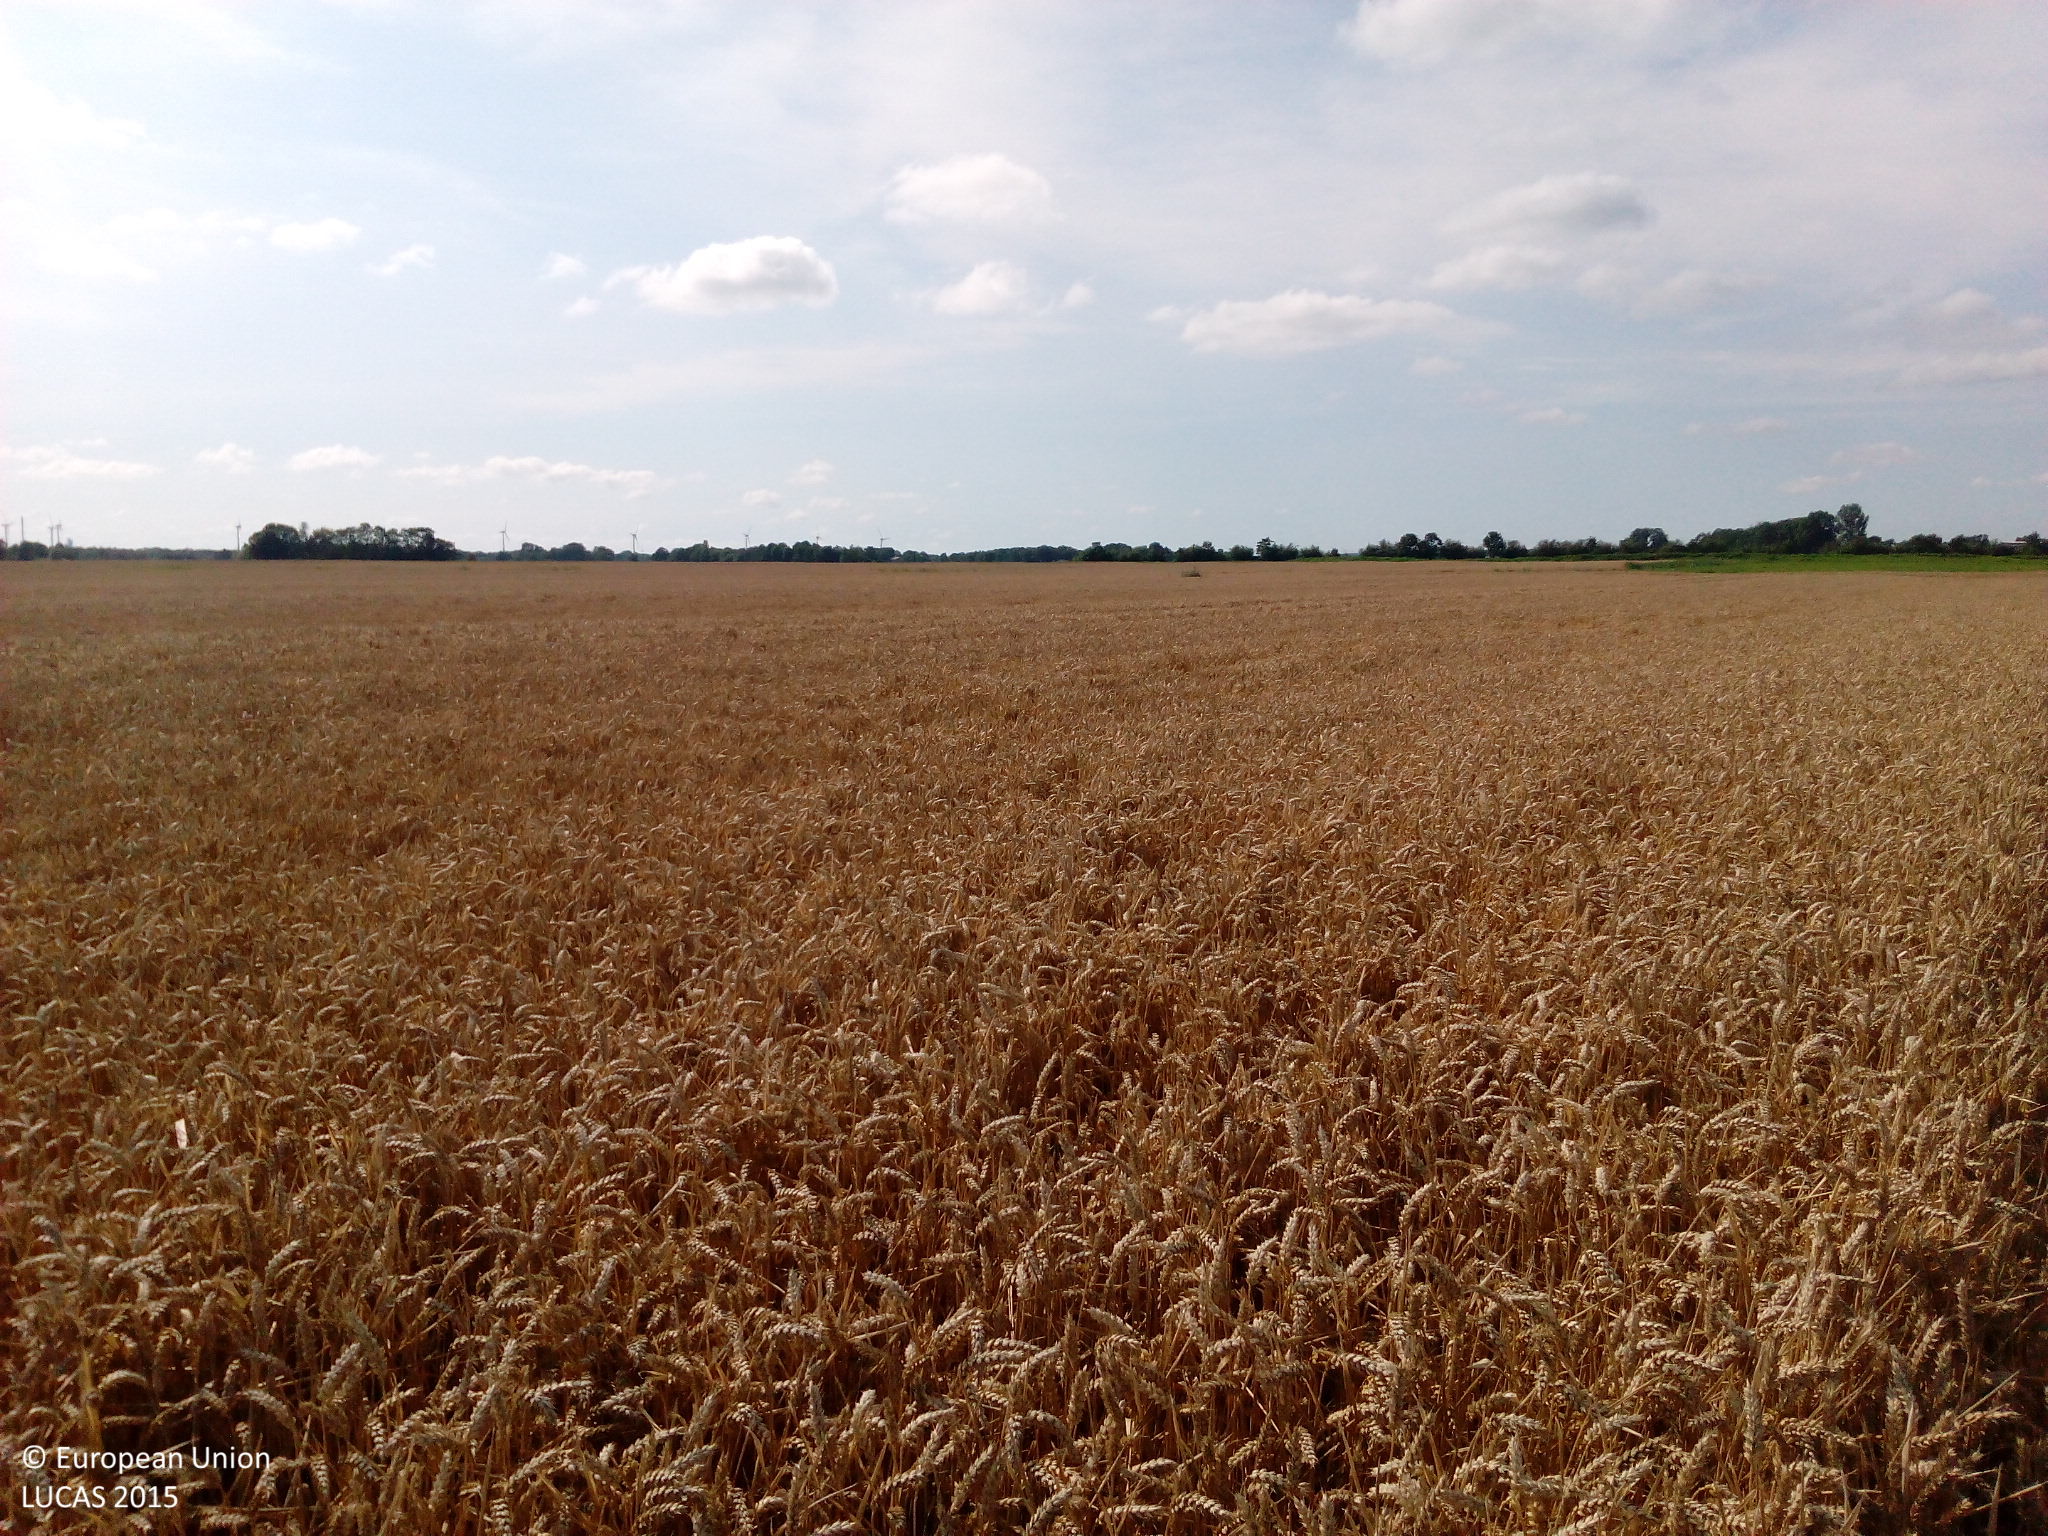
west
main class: Cropland
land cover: Common wheat
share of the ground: > 75 %
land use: Agriculture (excluding fallow land and kitchen gardens)
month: August
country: DE
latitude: 53.9392
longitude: 9.3149
